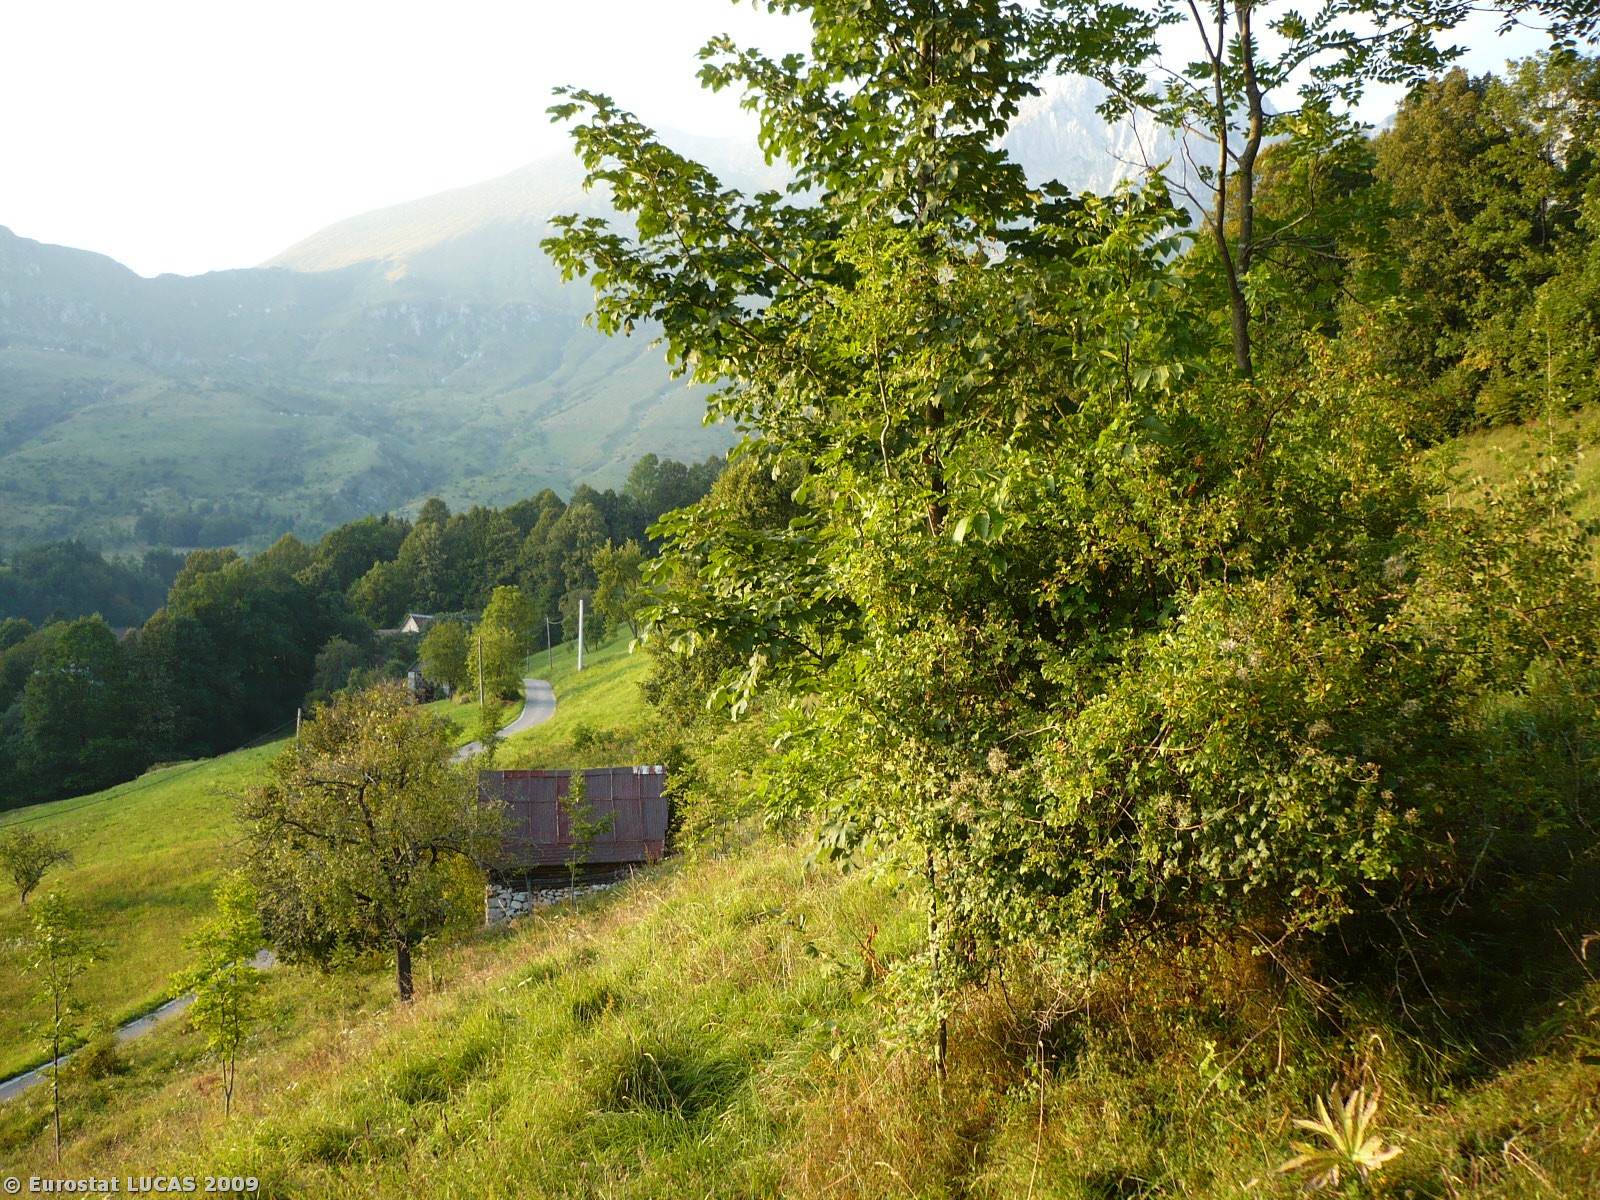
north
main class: Grassland
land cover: Grassland with sparse tree/shrub cover
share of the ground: > 75 %
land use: Fallow land
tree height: > 5 m
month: August
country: SI
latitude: 46.2343
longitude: 13.6663
